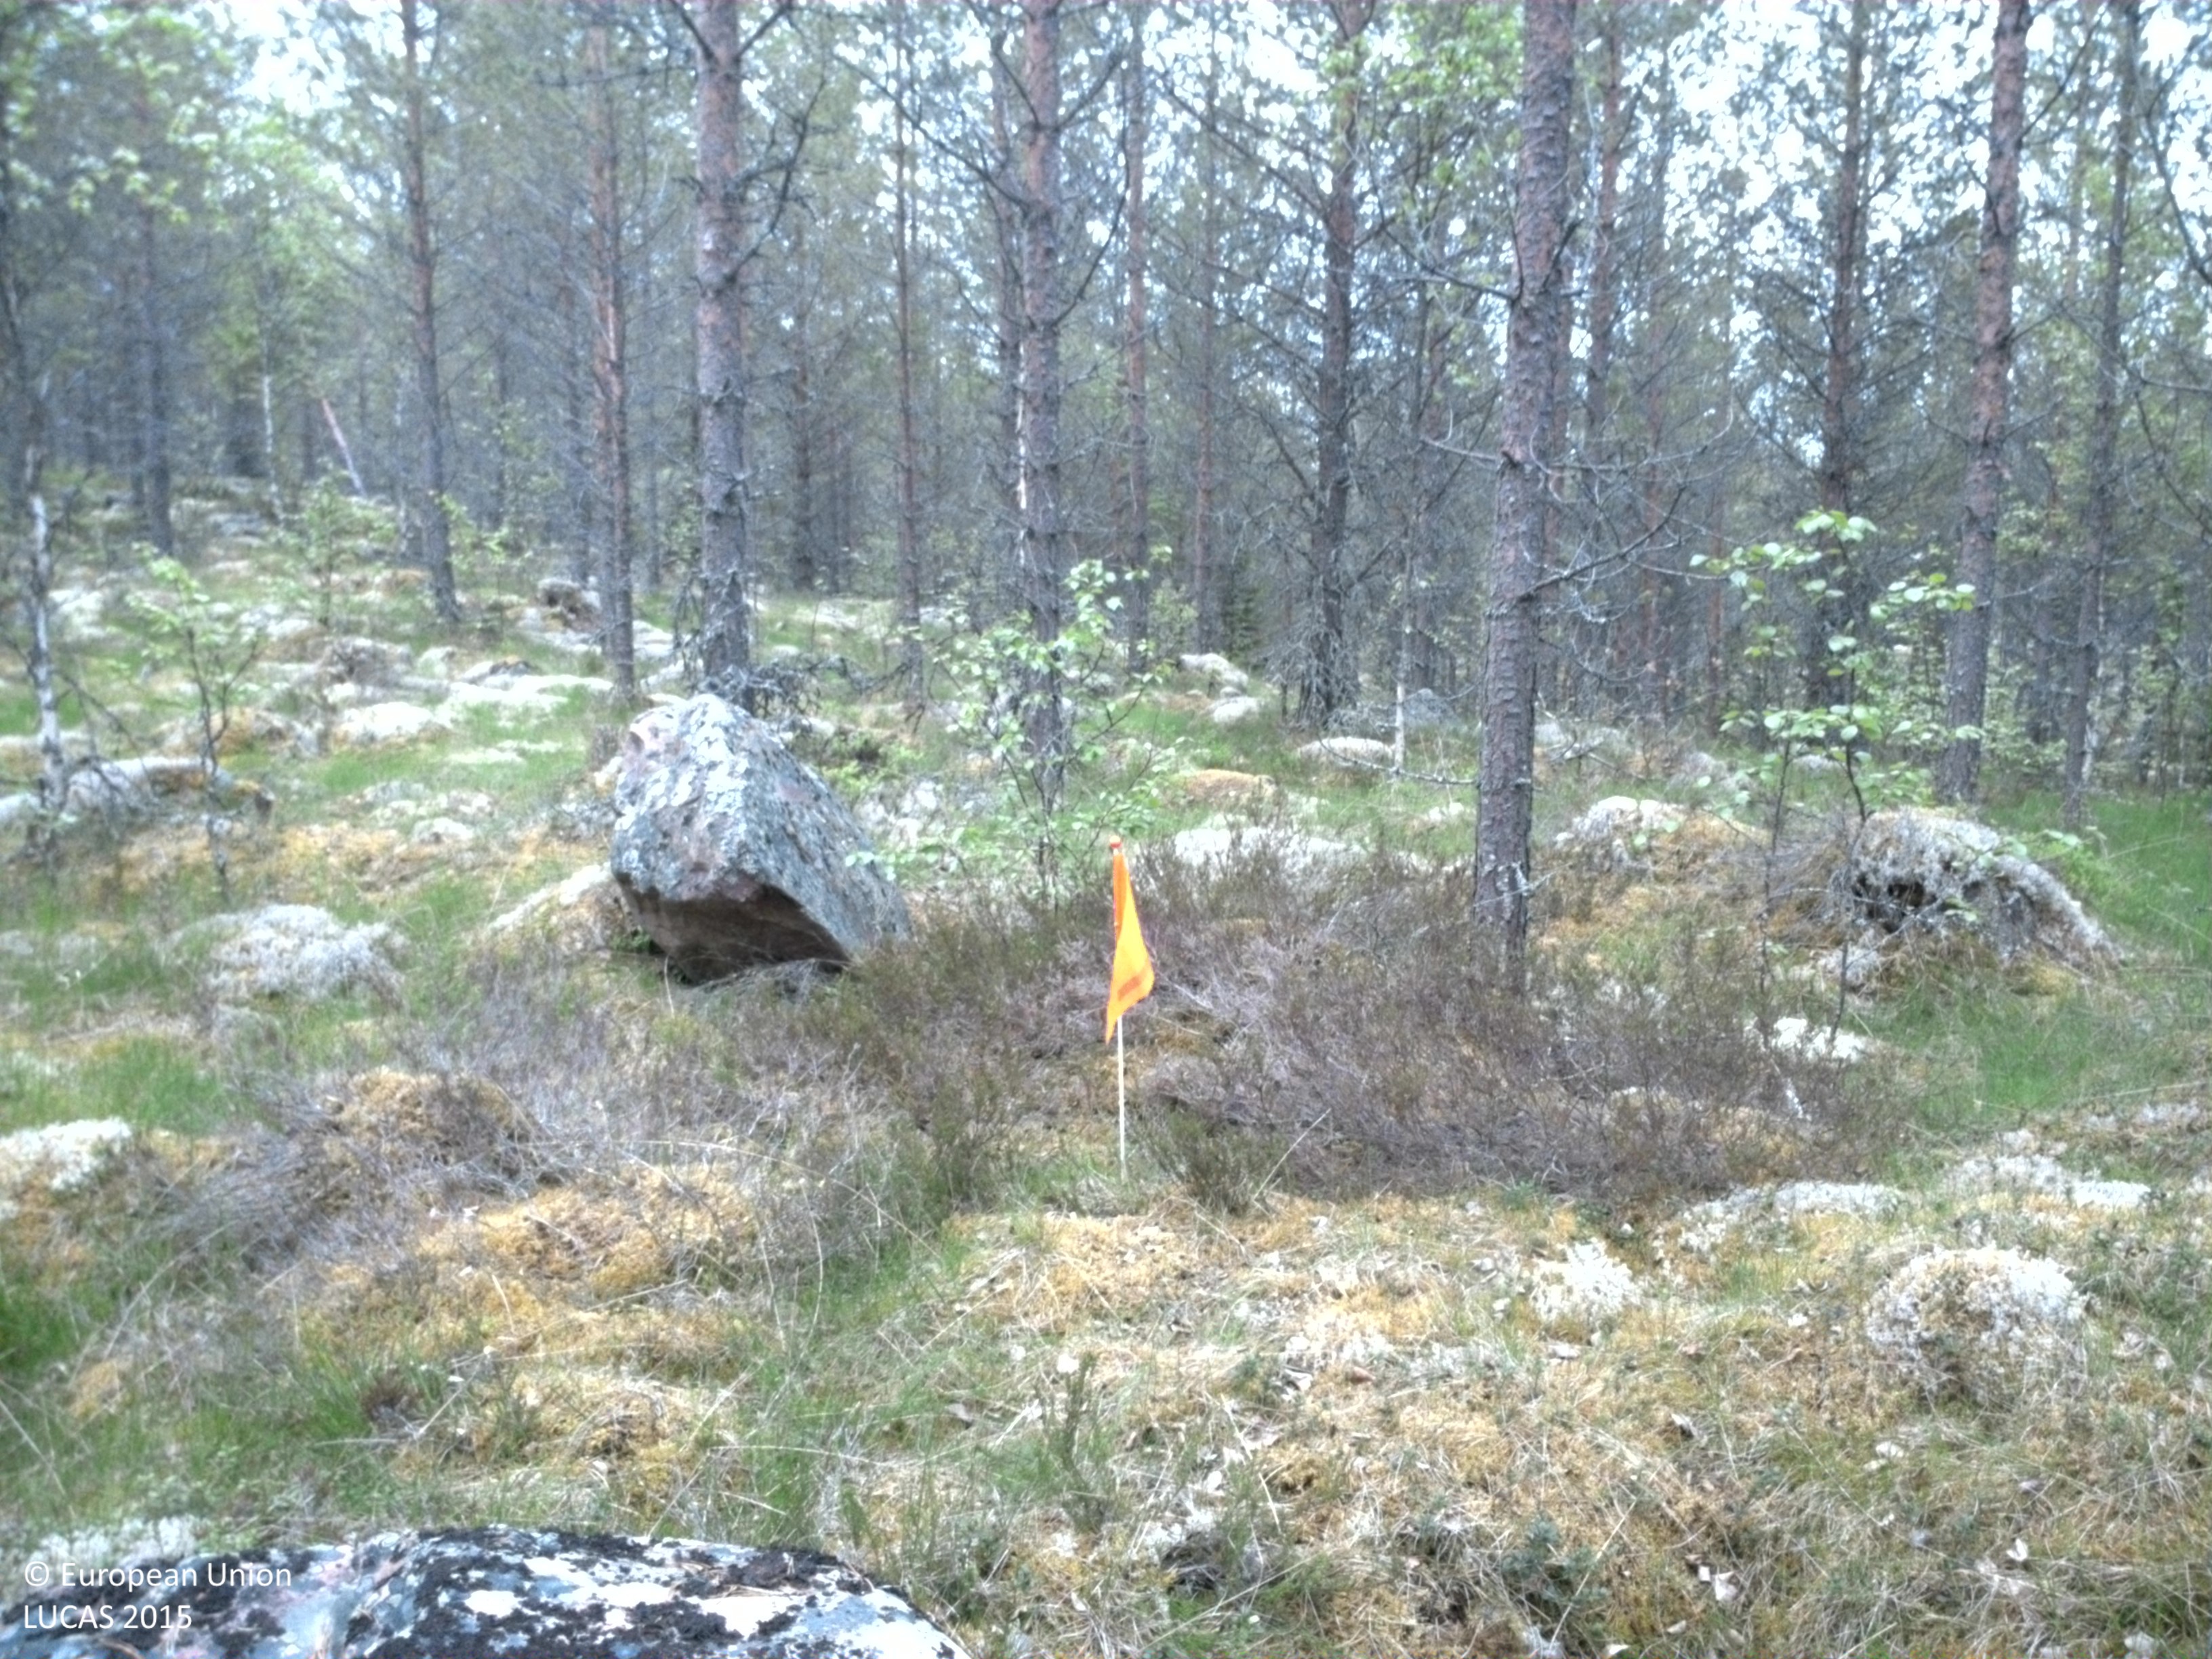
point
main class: Woodland
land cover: Pine dominated coniferous woodland
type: boreal forest
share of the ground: 50 - 75 %
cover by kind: coniferous forest trees 45 %, lichens and mosses 25 %, herbaceous plants 20 %, broadleaved forest trees 5 %, shrubs 5 %
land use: Forestry
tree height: > 5 m
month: June
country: SE
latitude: 61.3660
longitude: 13.3738
